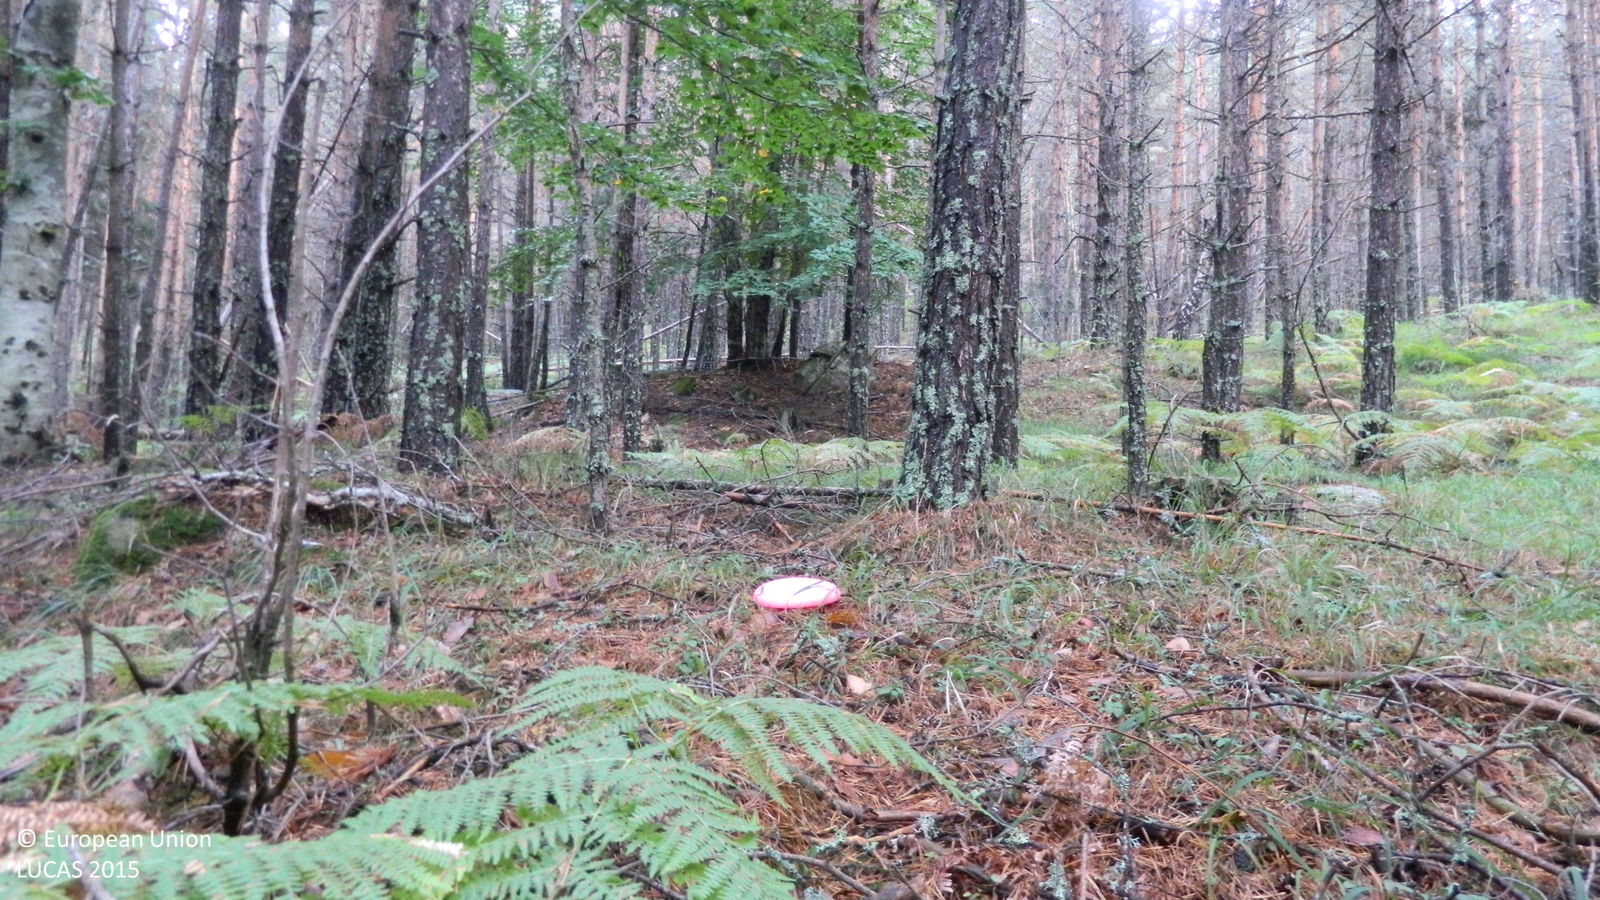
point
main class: Woodland
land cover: Pine dominated coniferous woodland
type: hemiboreal forest and nemoral coniferous forest and mixed broadleaved-coniferous forest
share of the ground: > 75 %
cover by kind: coniferous forest trees 95 %, herbaceous plants 5 %
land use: Forestry
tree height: > 5 m
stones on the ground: < 10 %
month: September
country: BG
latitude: 41.6480
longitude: 24.0702
